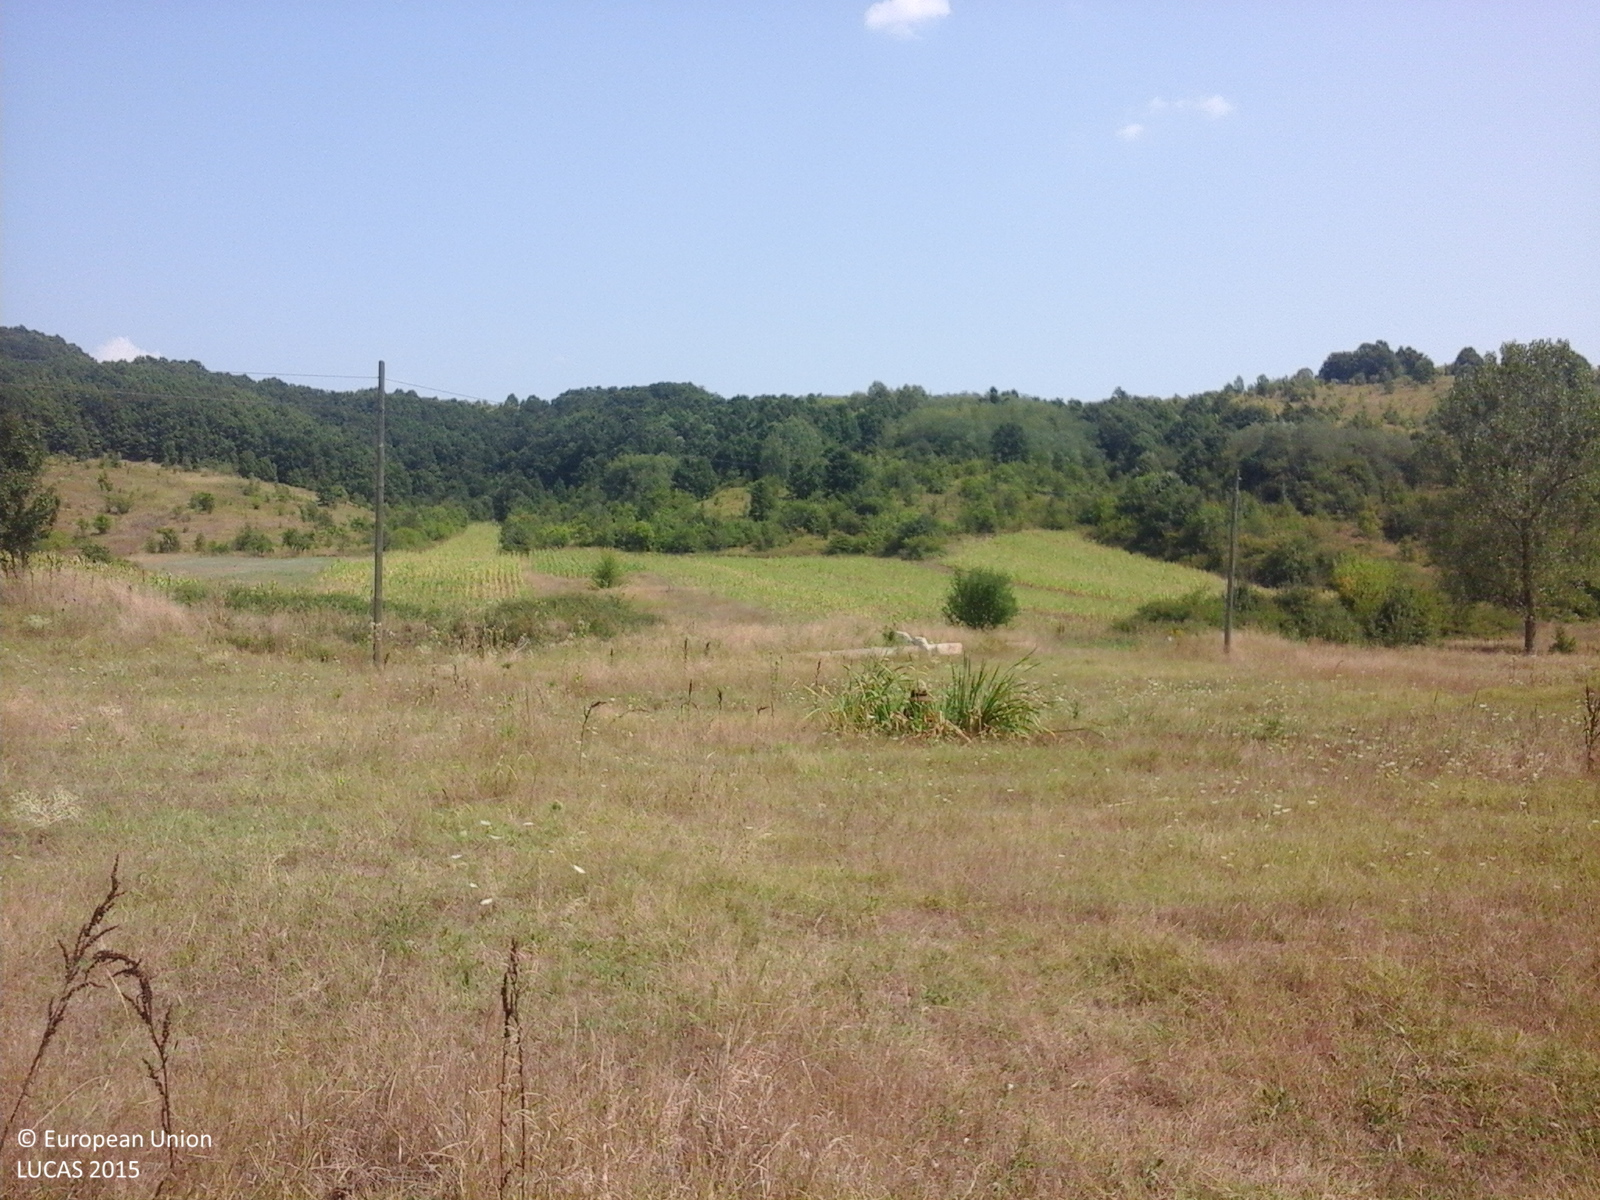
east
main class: Grassland
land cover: Grassland without tree/shrub cover
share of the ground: > 75 %
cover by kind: herbaceous plants 100 %
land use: Agriculture (excluding fallow land and kitchen gardens)
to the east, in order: Grassland without tree/shrub cover; Electric lines; Grassland without tree/shrub cover; Grass margins; Tracks; Grass margins; Tracks; Abandoned hedges; Spontaneously vegetated surfaces; Maize
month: August
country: RO
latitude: 44.6733
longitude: 23.7455
